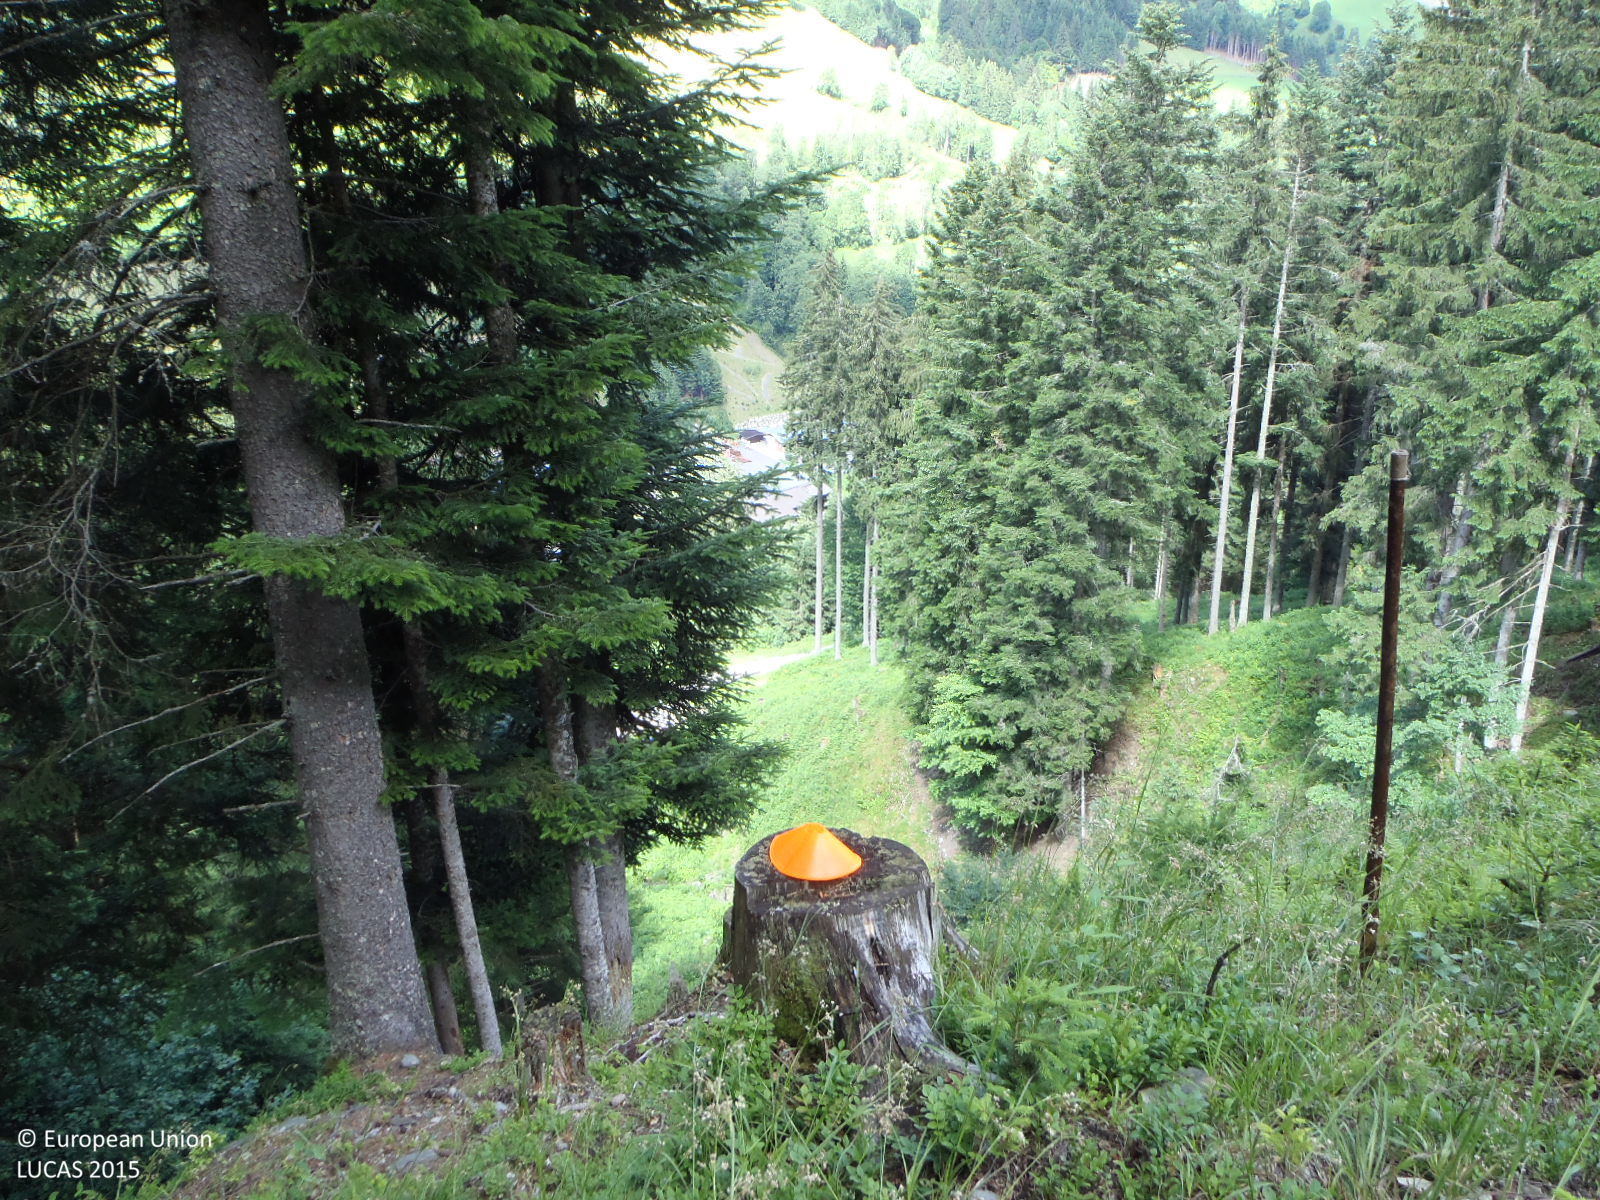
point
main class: Woodland
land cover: Spruce dominated coniferous woodland
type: alpine coniferous forest
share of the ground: 50 - 75 %
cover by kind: coniferous forest trees 60 %, broadleaved forest trees 10 %, shrubs 10 %, herbaceous plants 10 %, lichens and mosses 10 %
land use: Forestry
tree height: > 5 m
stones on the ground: < 10 %
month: June
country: AT
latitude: 47.3811
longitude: 12.6605
